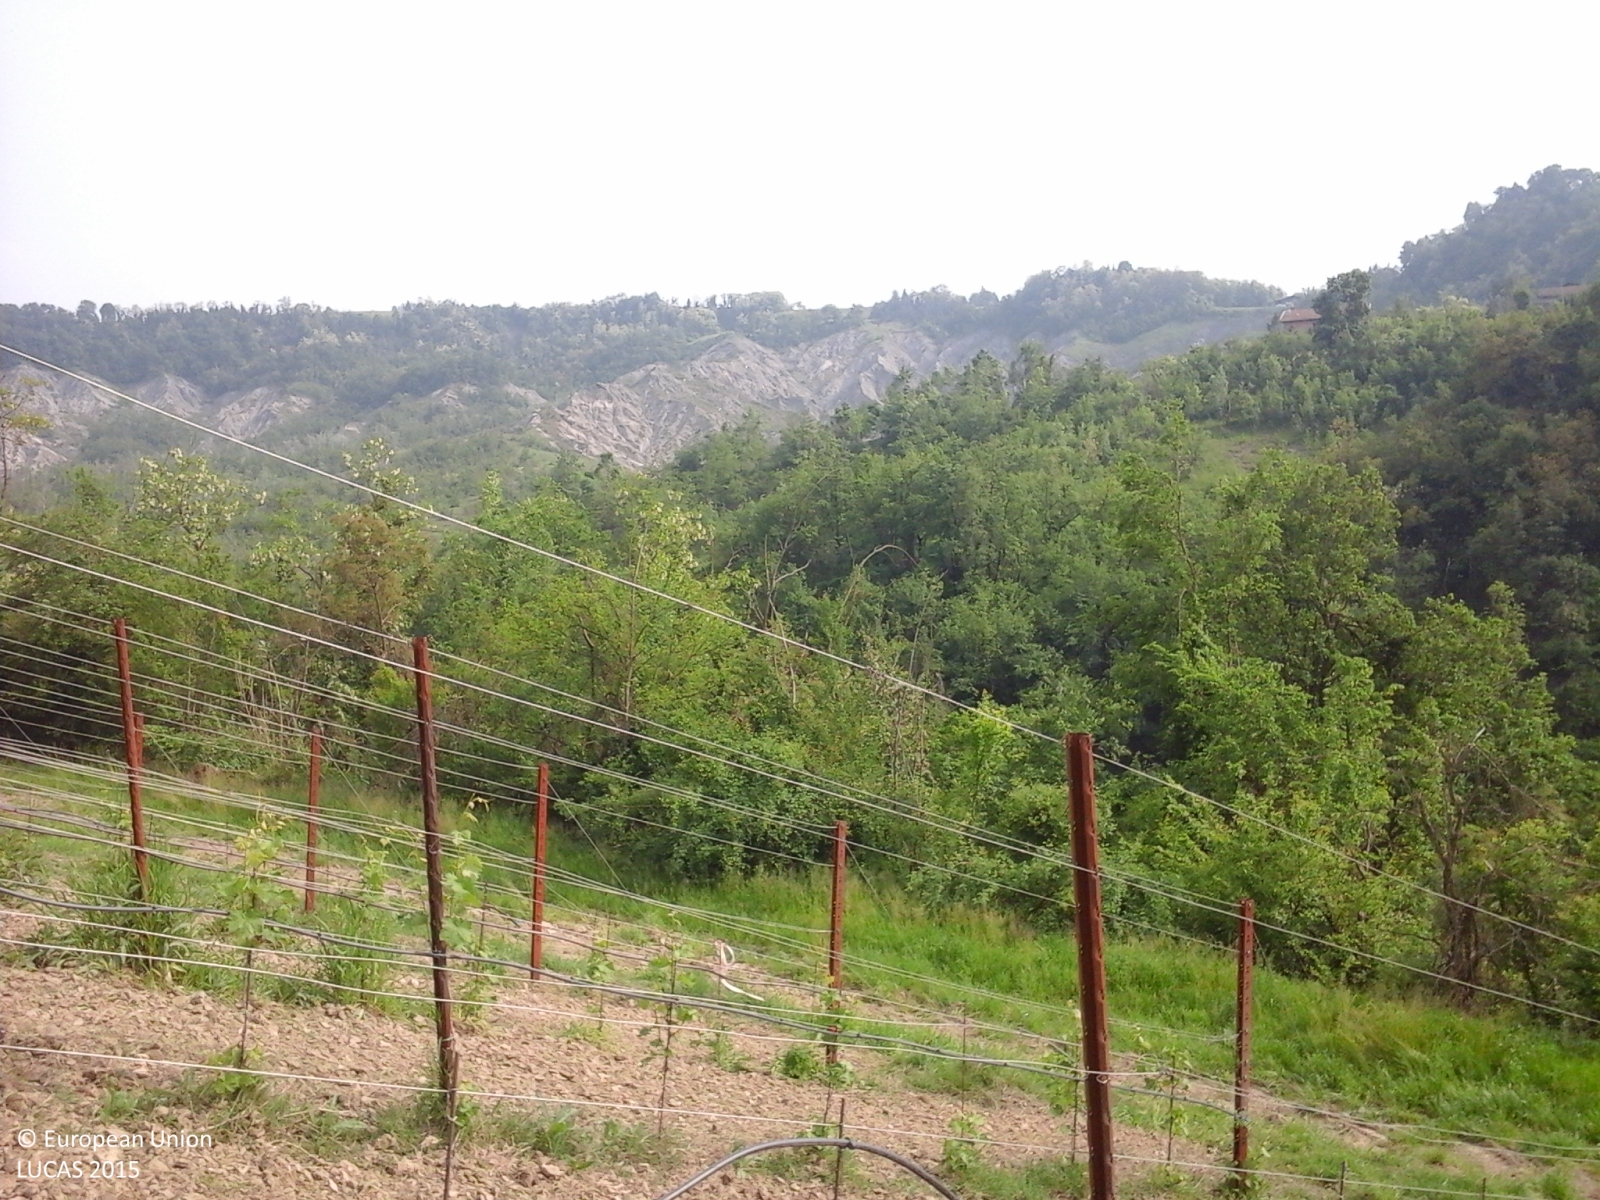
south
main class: Cropland
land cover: Vineyards
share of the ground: < 10 %
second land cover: Other bare soil
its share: > 75 %
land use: Agriculture (excluding fallow land and kitchen gardens)
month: May
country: IT
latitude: 44.4713
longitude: 11.0662
